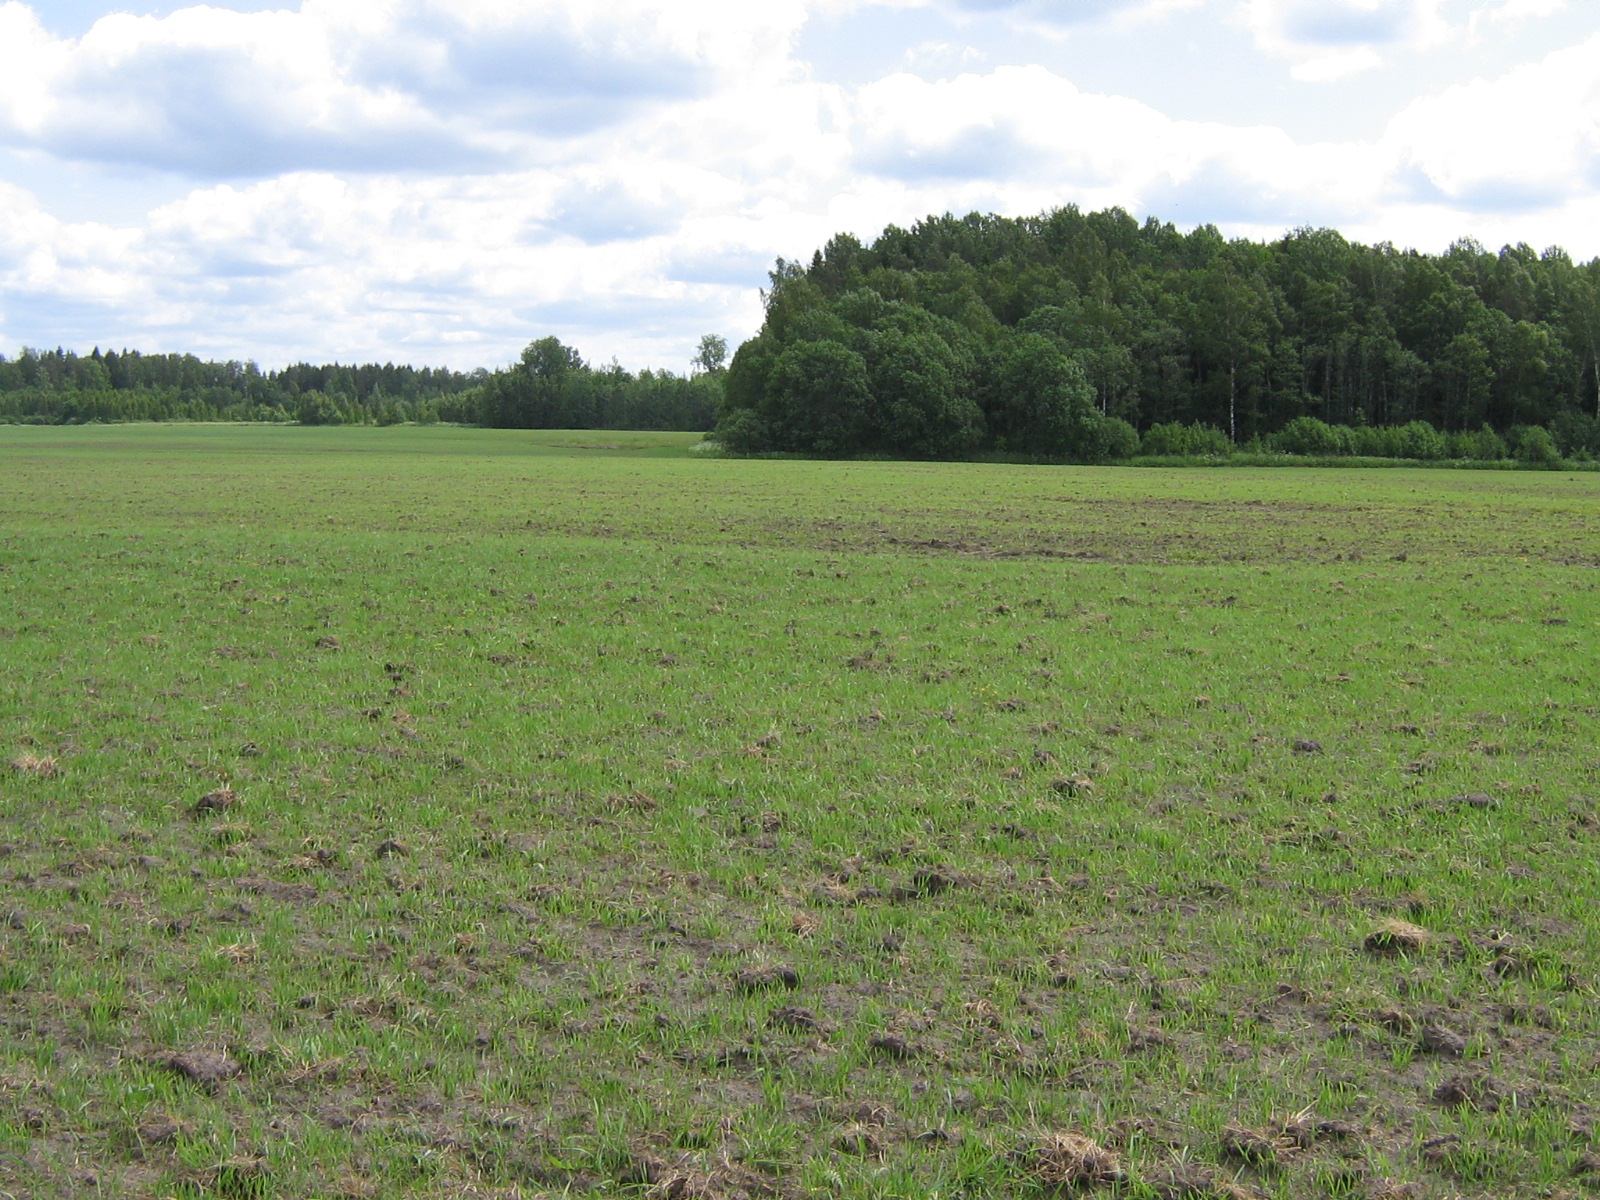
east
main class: Cropland
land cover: Rye
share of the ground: 50 - 75 %
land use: Agriculture (excluding fallow land and kitchen gardens)
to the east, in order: Rye; Common wheat
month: June
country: LV
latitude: 56.6683
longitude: 25.5071
